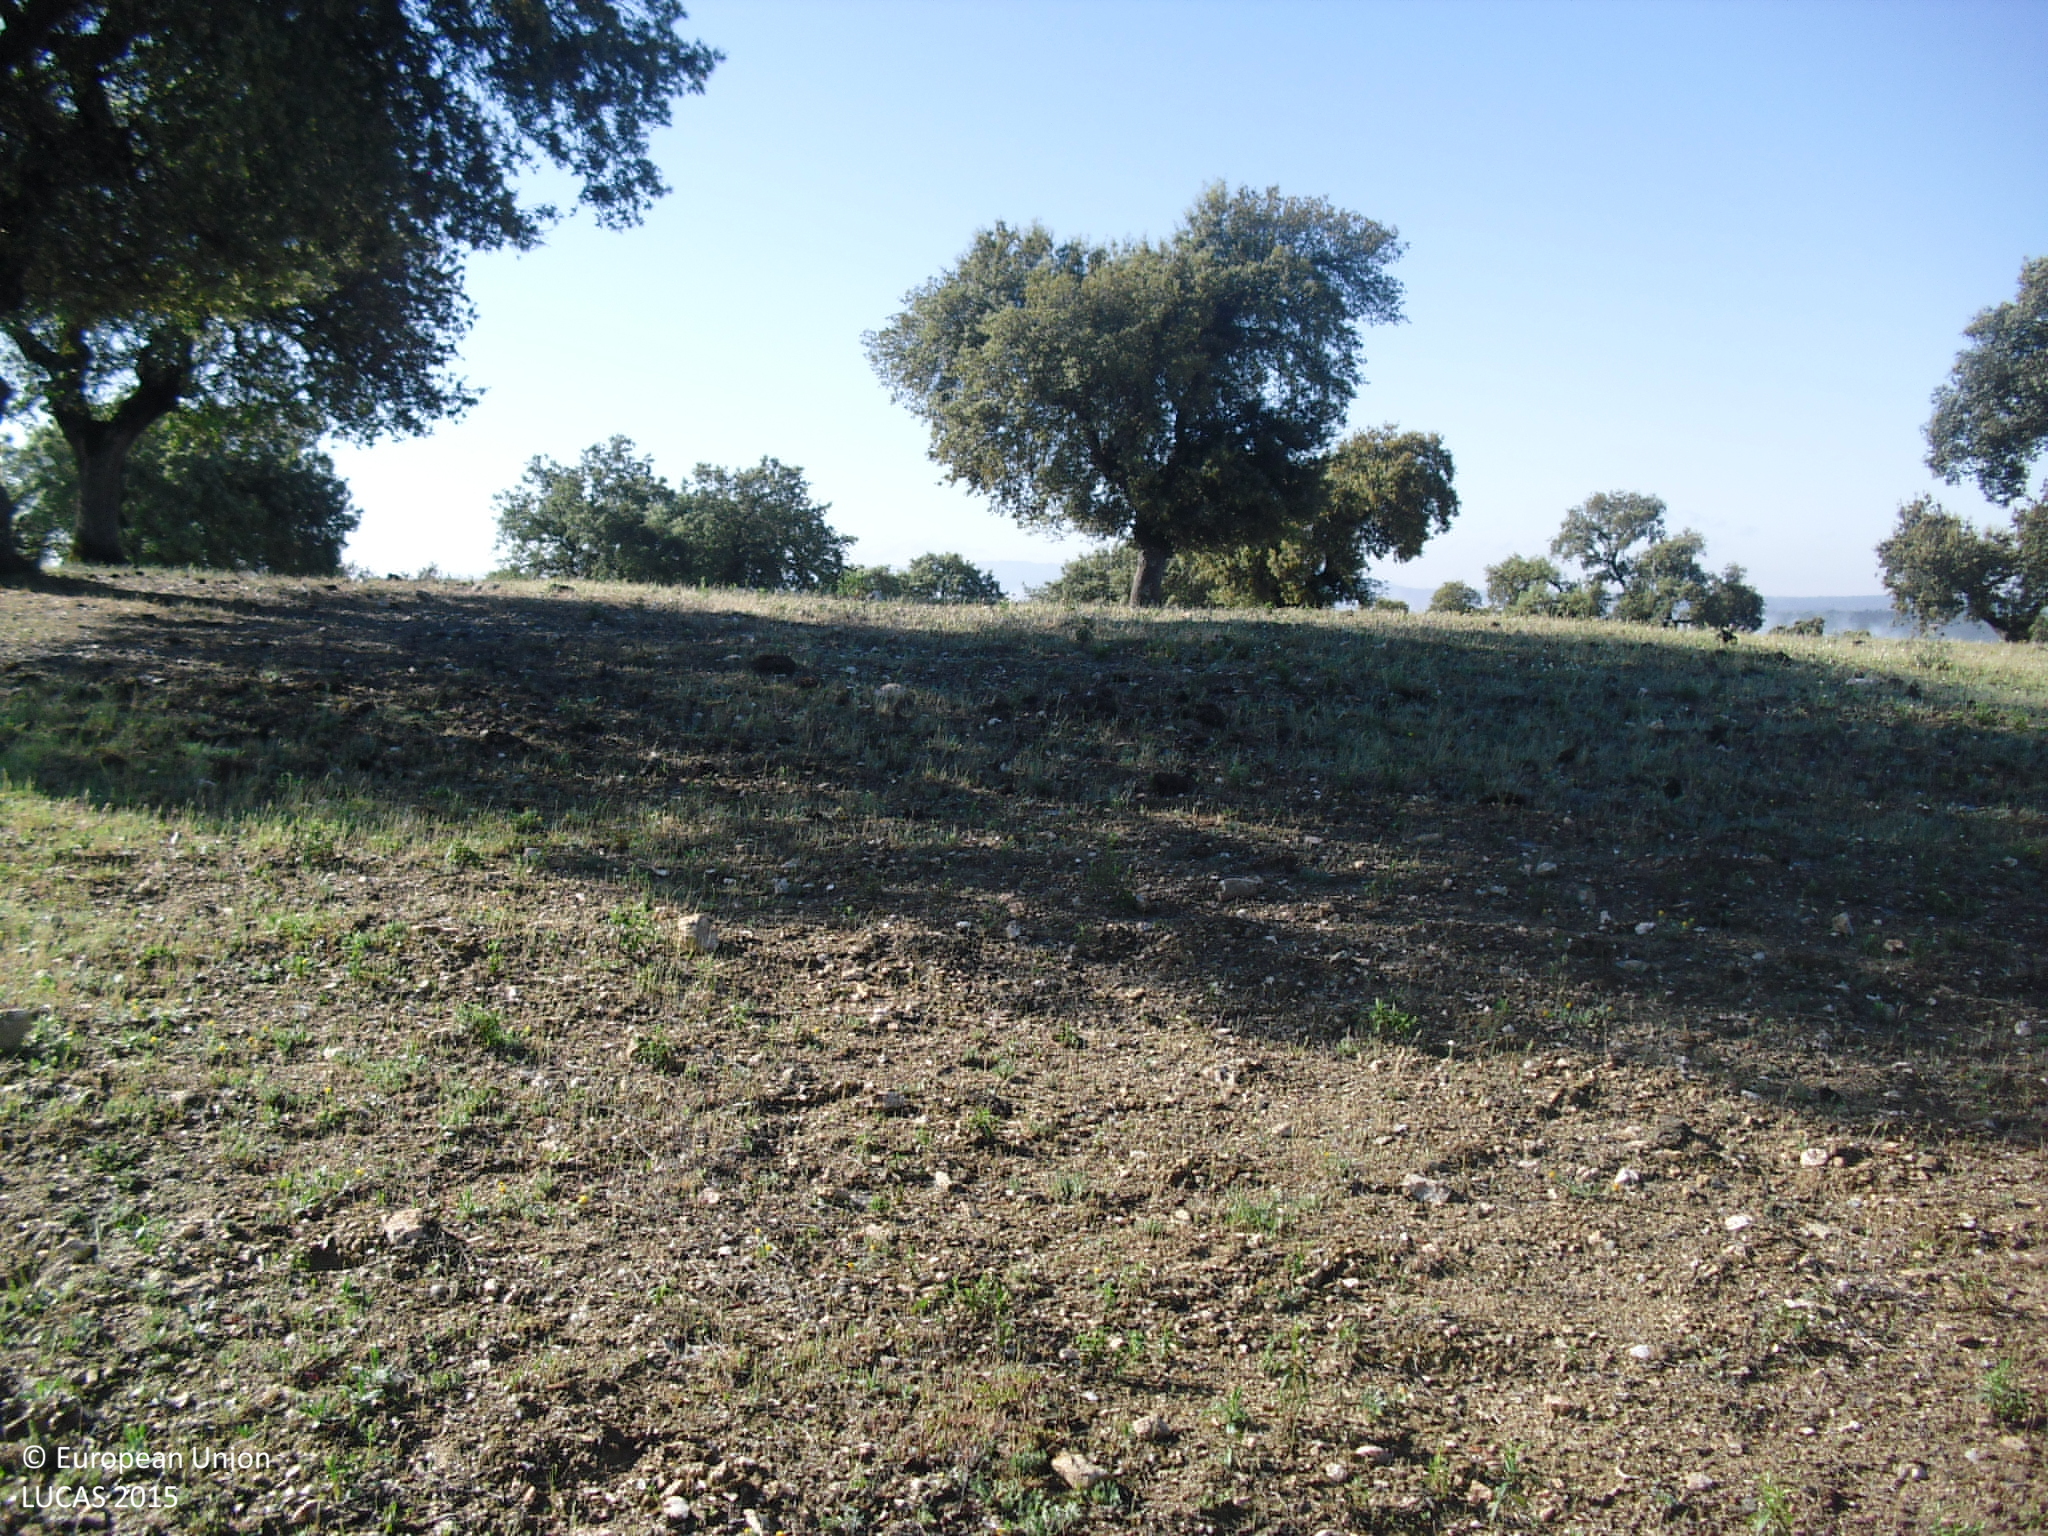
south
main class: Woodland
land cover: Broadleaved woodland
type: broadleaved evergreen forest
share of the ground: 10 - 25 %
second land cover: Spontaneously vegetated surfaces
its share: > 75 %
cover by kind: herbaceous plants 80 %, broadleaved forest trees 20 %
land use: Forestry
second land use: Agriculture (excluding fallow land and kitchen gardens)
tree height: > 5 m
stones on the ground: 10 - 25 %
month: April
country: ES
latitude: 39.5932
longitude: -7.4559
